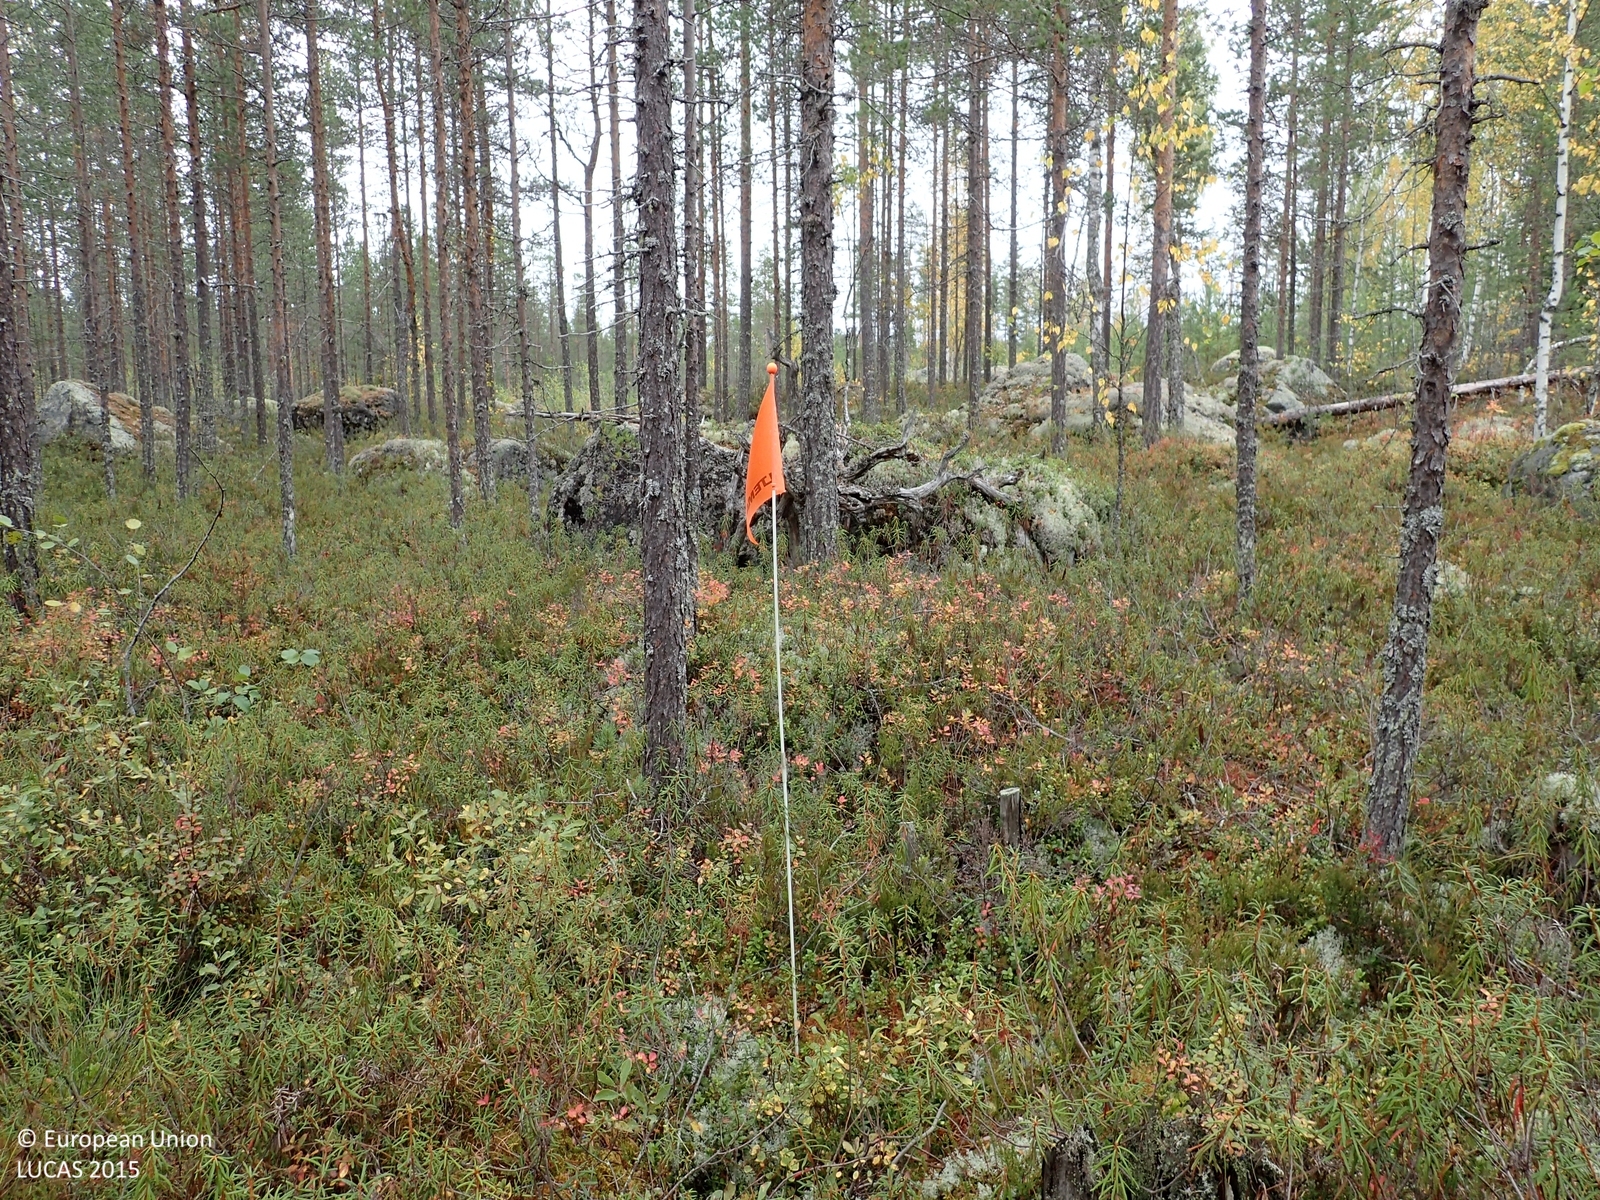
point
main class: Woodland
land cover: Pine dominated coniferous woodland
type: boreal forest
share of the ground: > 75 %
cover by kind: coniferous forest trees 70 %, shrubs 25 %, broadleaved forest trees 5 %
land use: Forestry
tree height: < 5 m
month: September
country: FI
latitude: 63.4586
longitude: 24.9942
